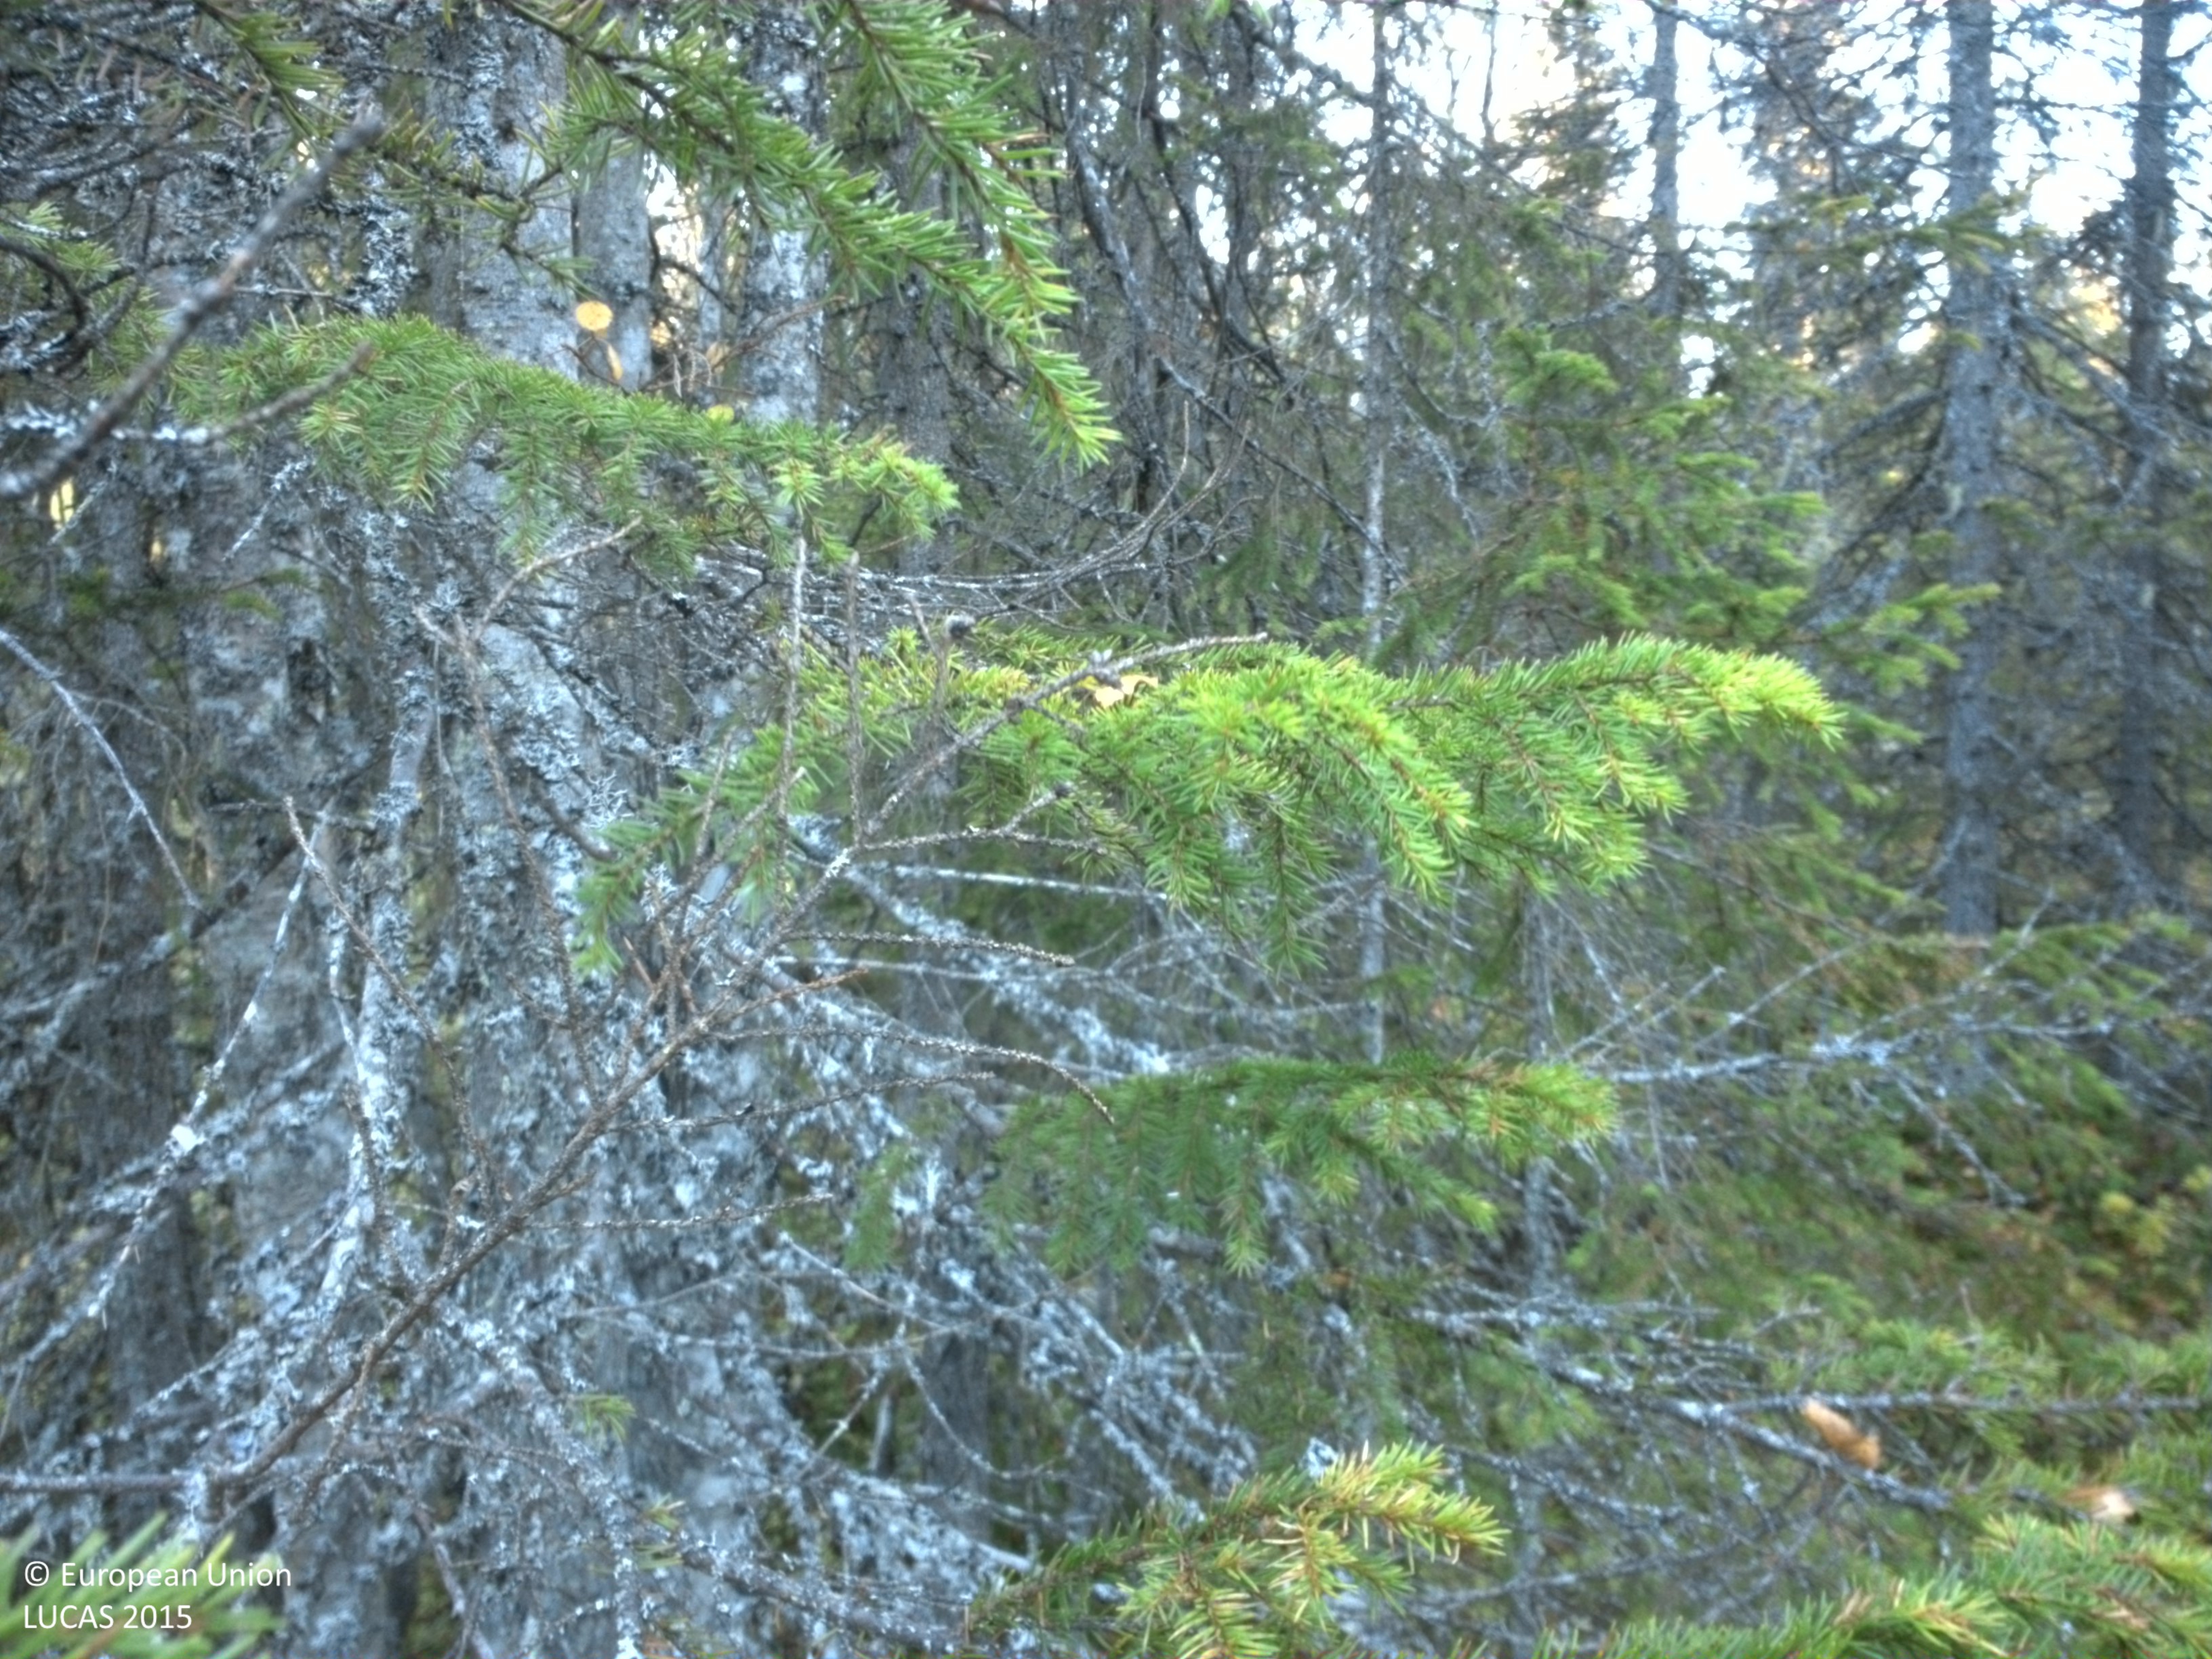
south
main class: Woodland
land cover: Spruce dominated mixed woodland
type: boreal forest
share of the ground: 25 - 50 %
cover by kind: coniferous forest trees 30 %, shrubs 30 %, broadleaved forest trees 20 %, lichens and mosses 10 %, herbaceous plants 5 %, consolidated bare surface 5 %
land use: Forestry
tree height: > 5 m
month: October
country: SE
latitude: 64.8763
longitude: 17.4582
